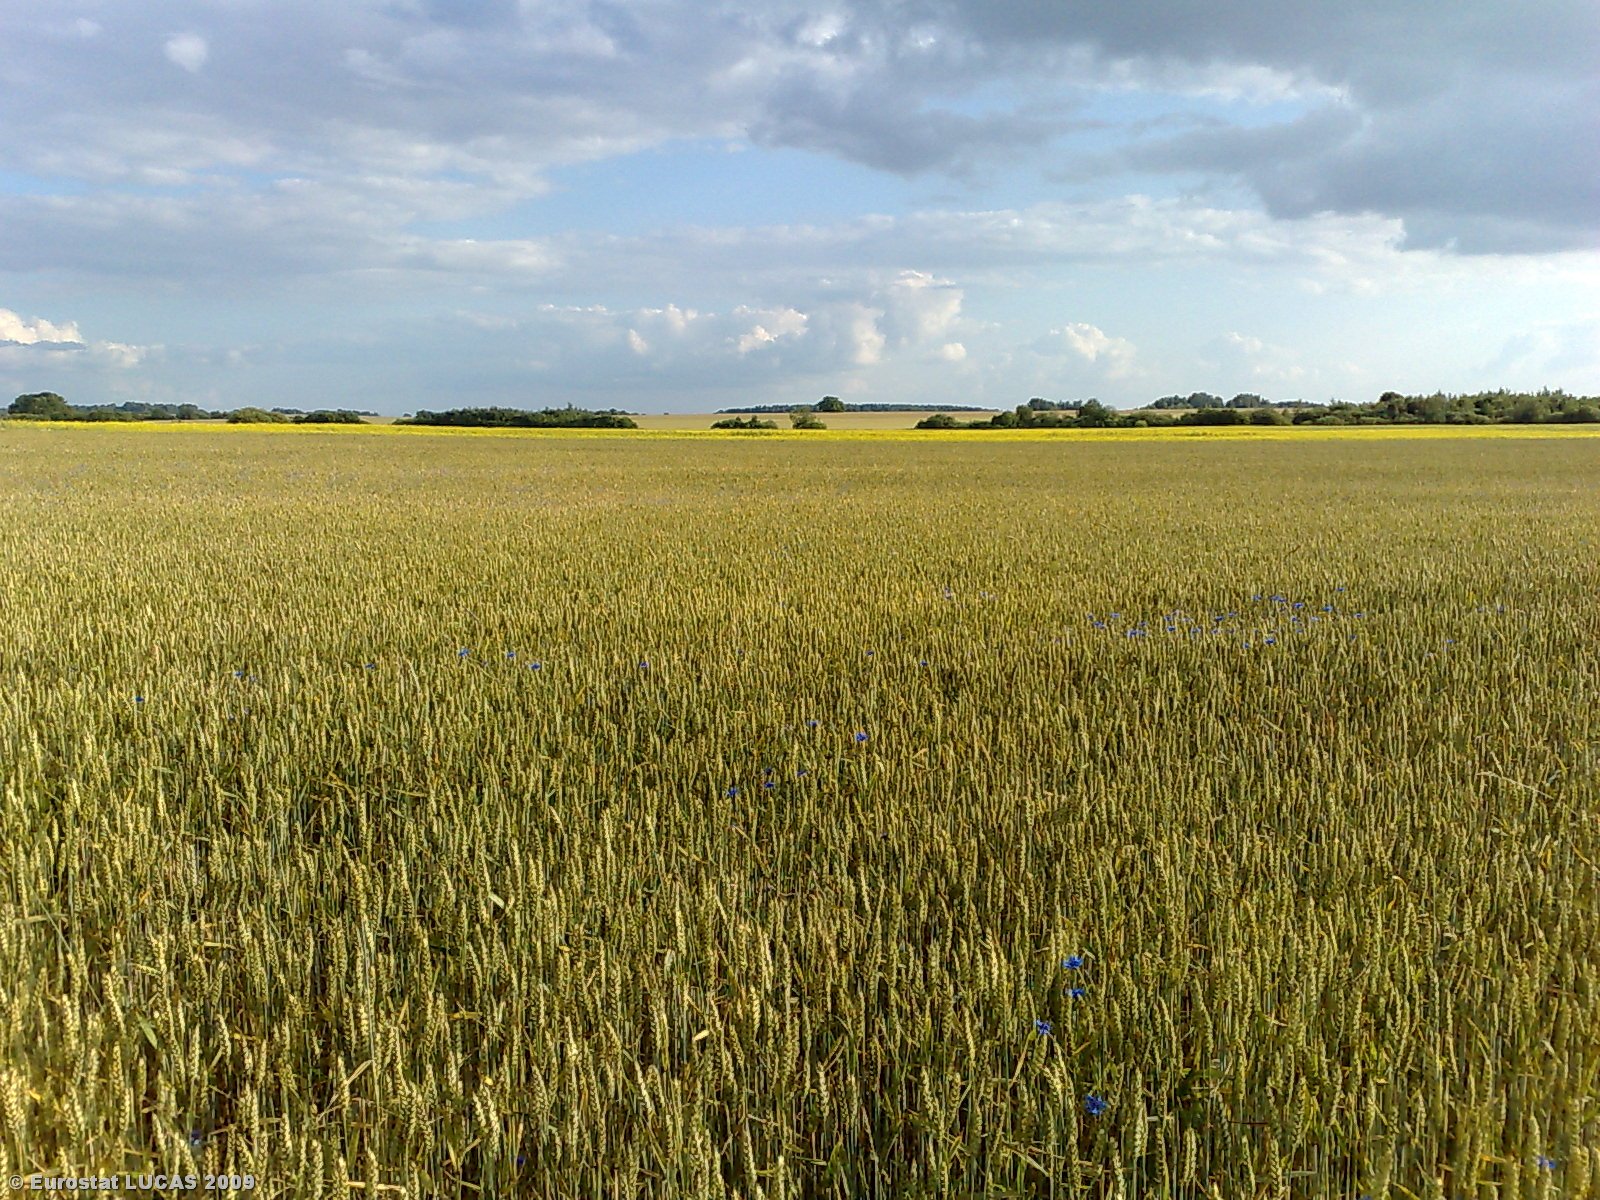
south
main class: Cropland
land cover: Common wheat
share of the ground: > 75 %
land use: Agriculture (excluding fallow land and kitchen gardens)
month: July
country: LT
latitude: 55.7414
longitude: 22.8243
